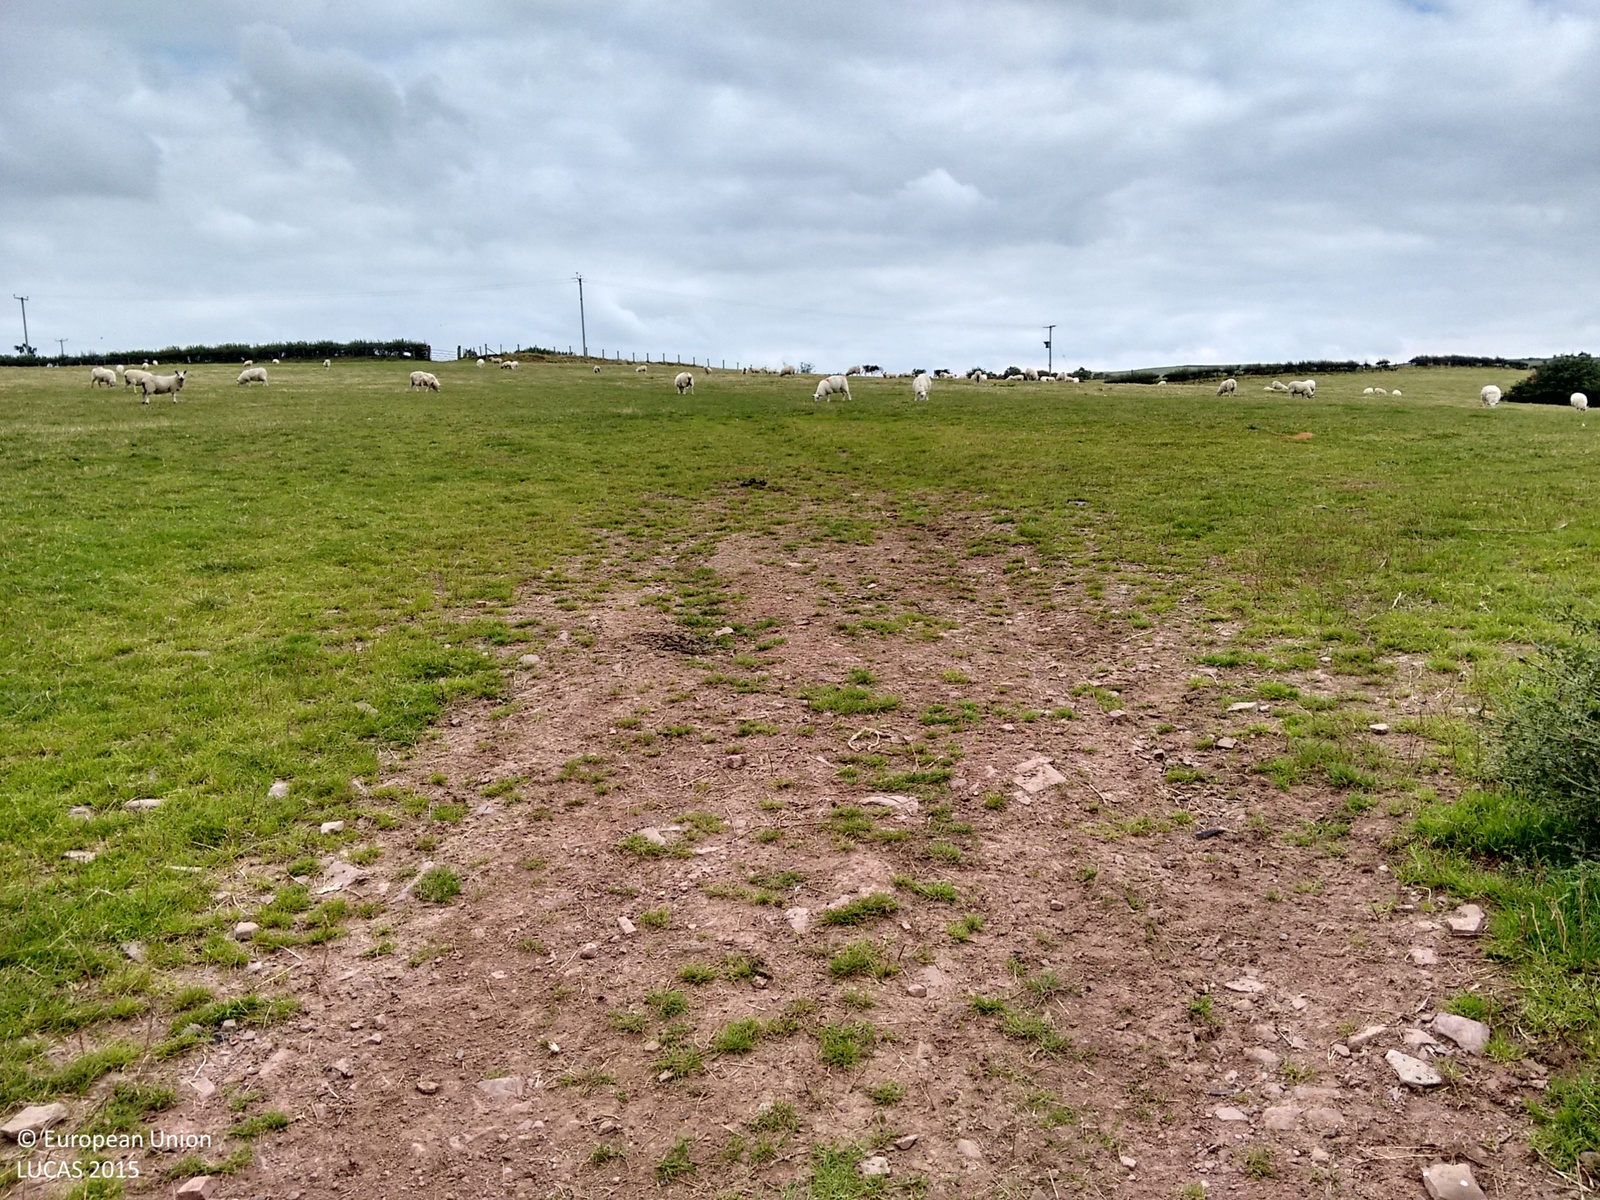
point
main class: Grassland
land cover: Grassland without tree/shrub cover
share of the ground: > 75 %
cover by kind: herbaceous plants 100 %
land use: Agriculture (excluding fallow land and kitchen gardens)
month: September
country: GB
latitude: 52.0623
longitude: -3.4592
